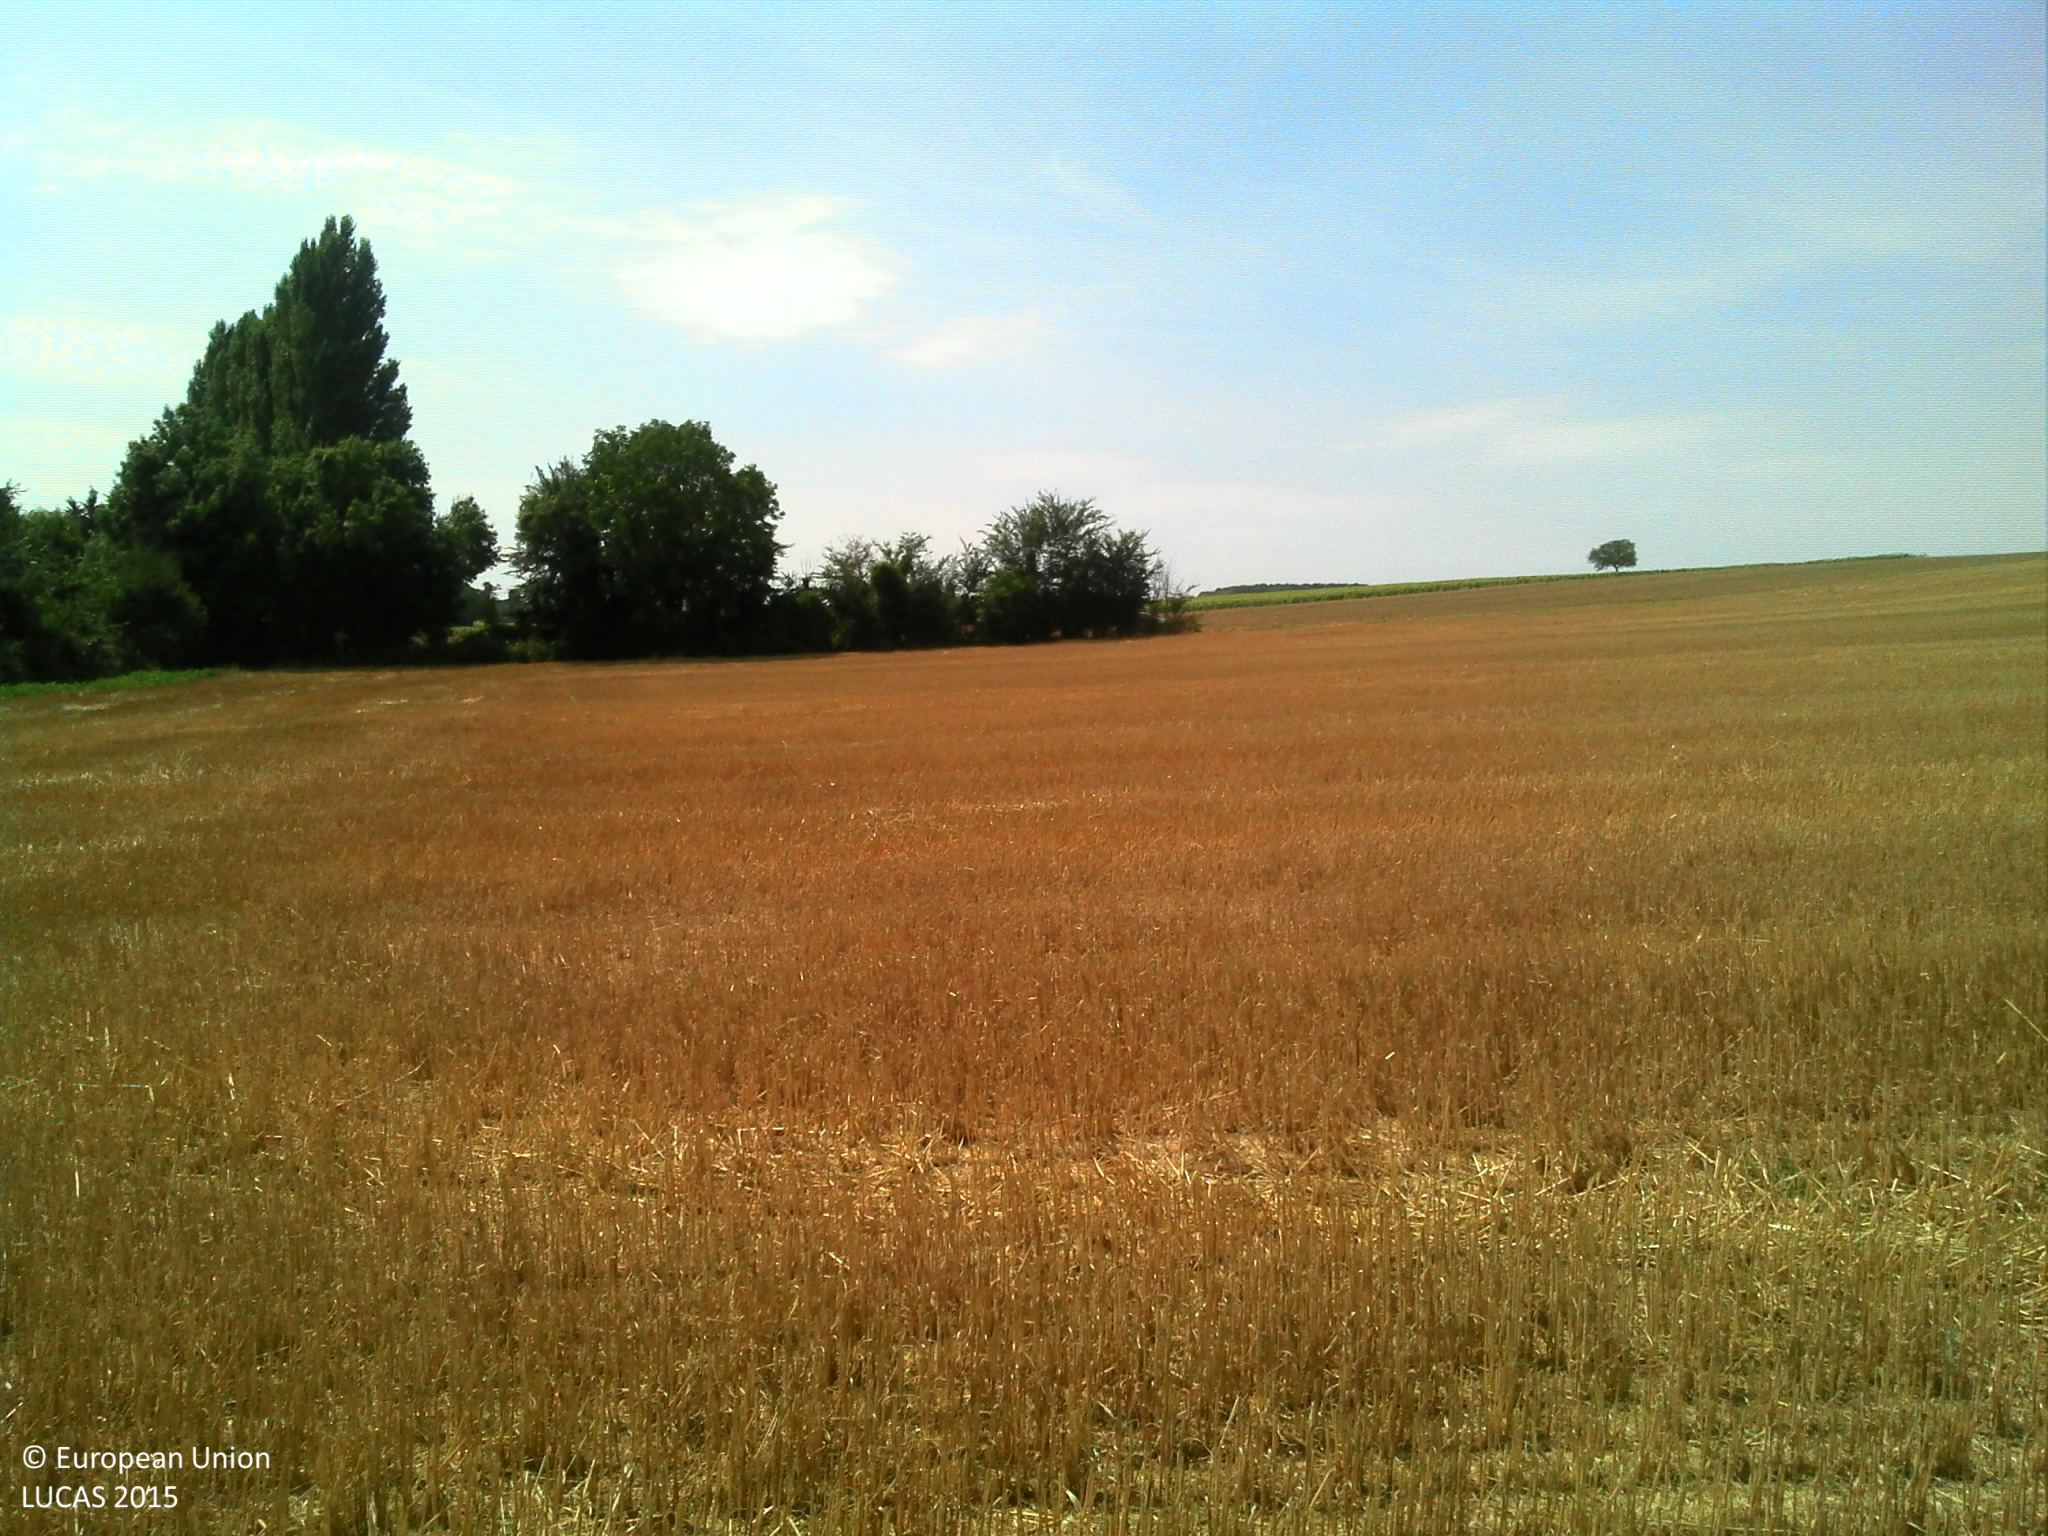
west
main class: Cropland
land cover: Common wheat
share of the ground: > 75 %
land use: Agriculture (excluding fallow land and kitchen gardens)
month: August
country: FR
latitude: 47.1293
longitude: 0.1557
